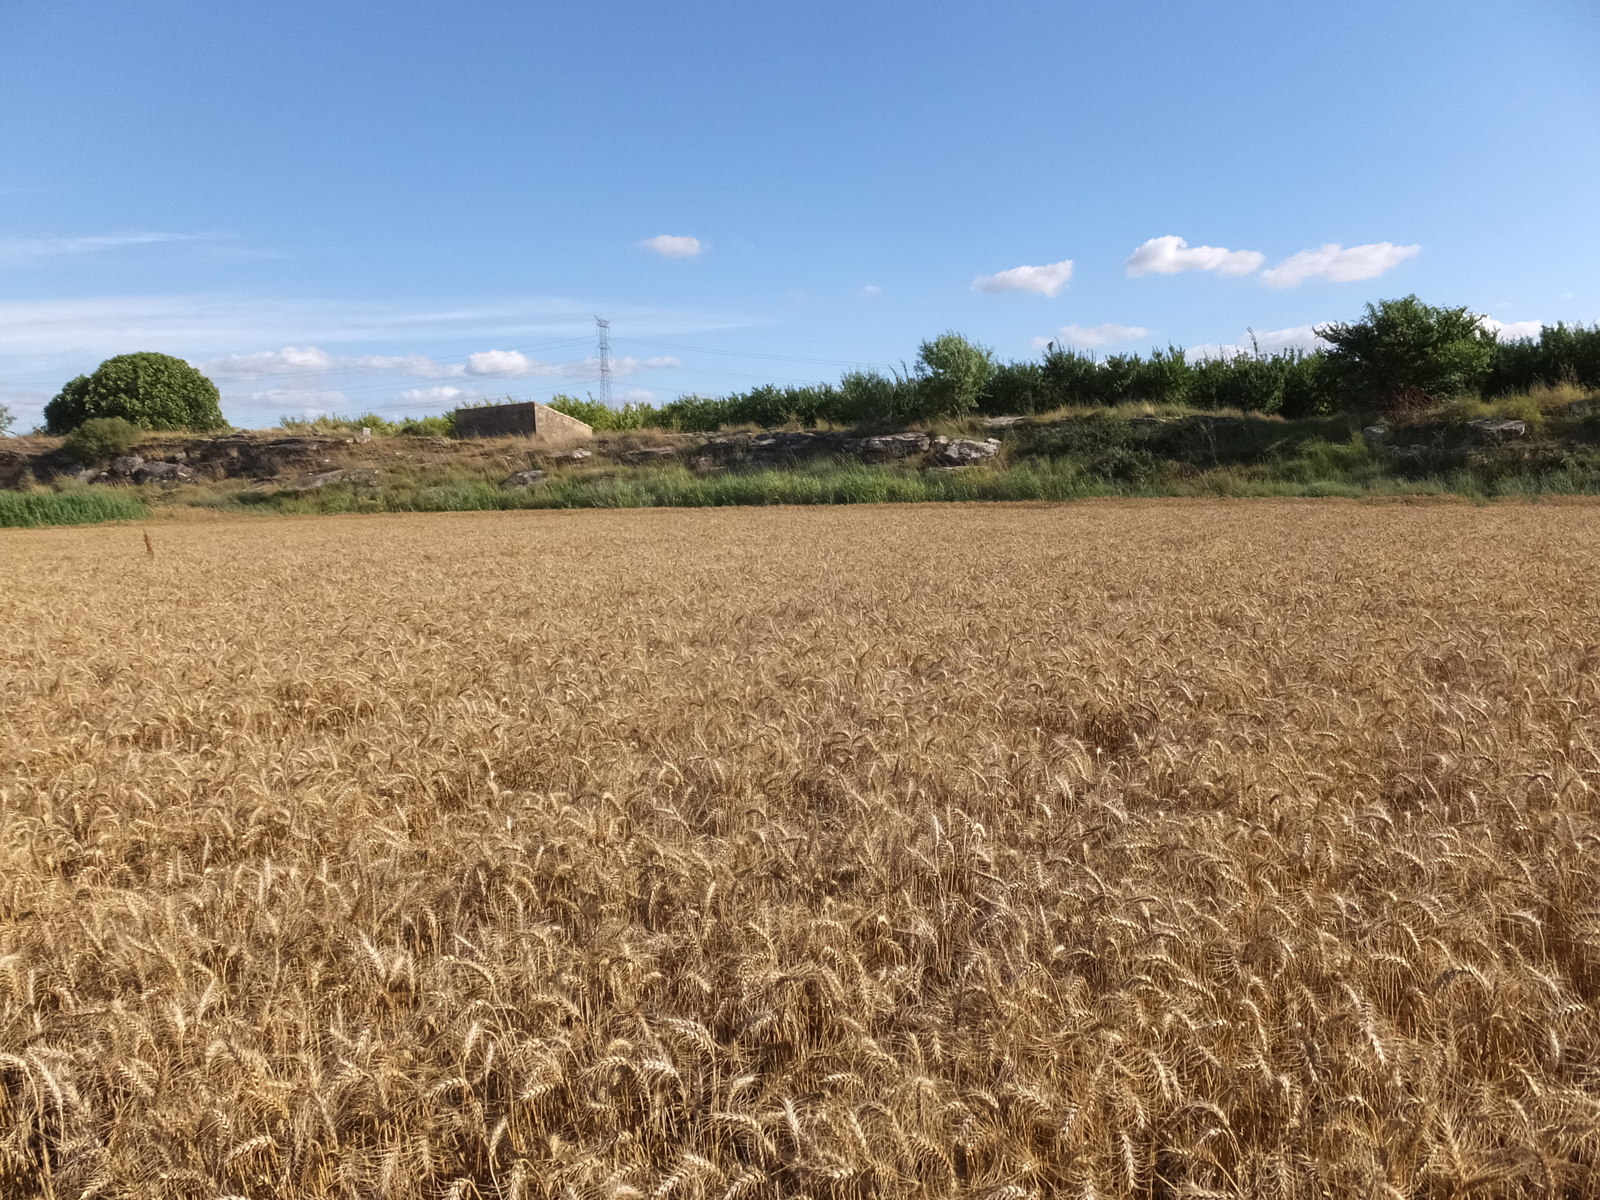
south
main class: Cropland
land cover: Durum wheat
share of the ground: > 75 %
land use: Agriculture (excluding fallow land and kitchen gardens)
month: June
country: ES
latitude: 41.2184
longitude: -0.1158
